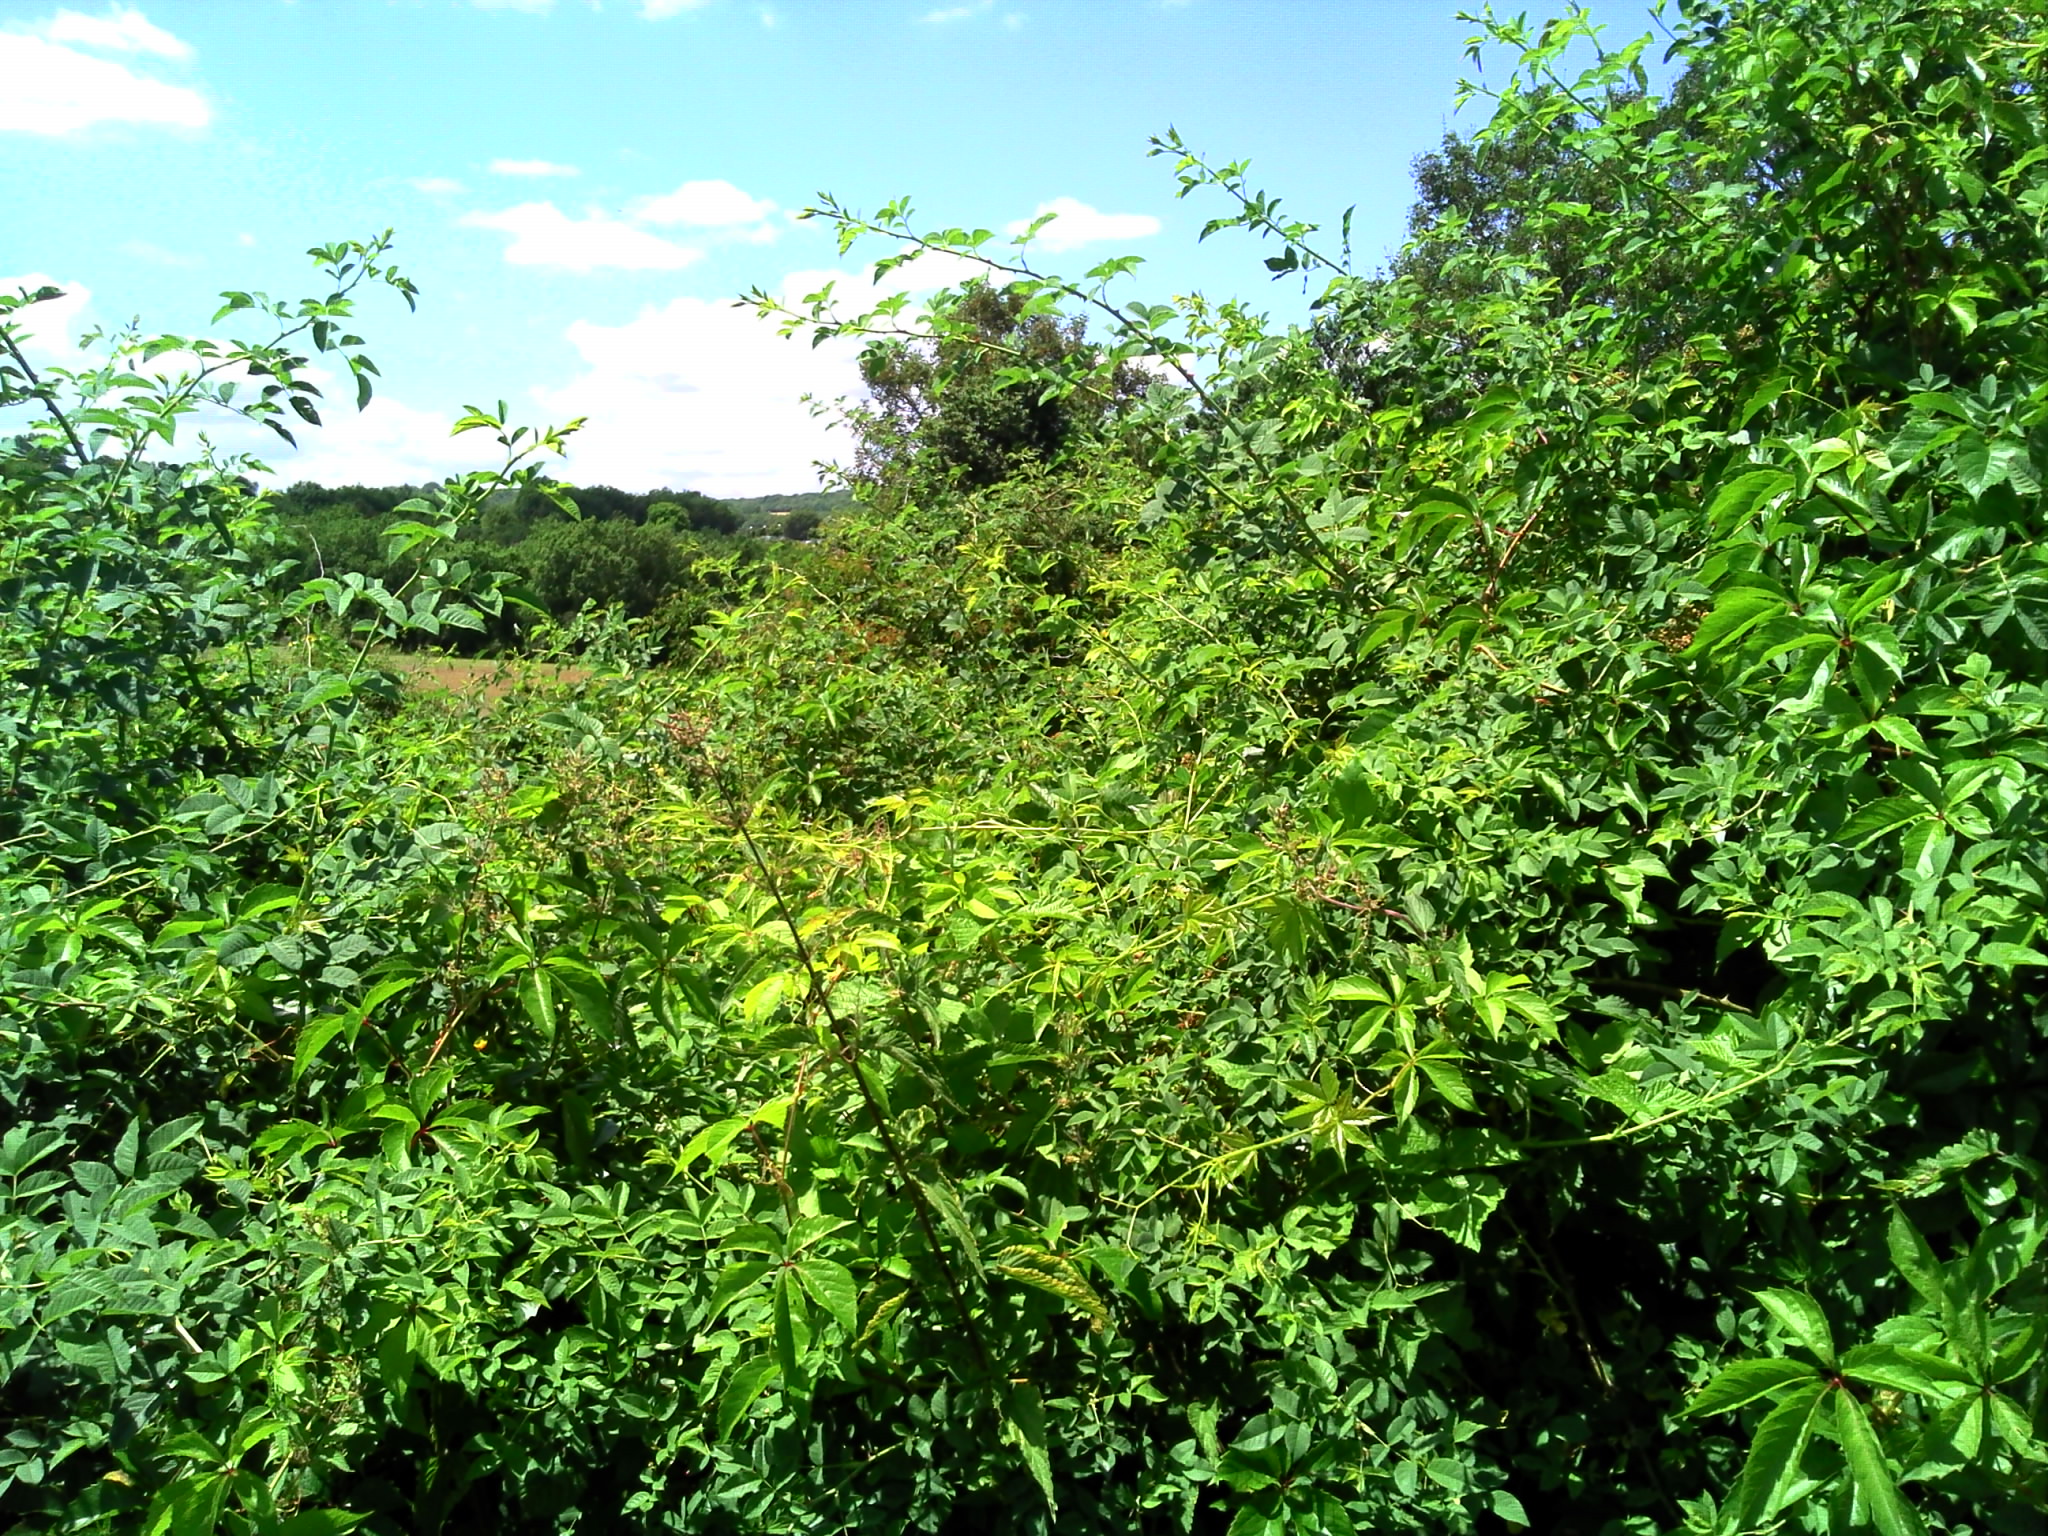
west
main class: Shrubland
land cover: Shrubland with sparse tree cover
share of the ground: > 75 %
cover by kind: shrubs 95 %, broadleaved forest trees 5 %
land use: Abandoned areas
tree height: < 5 m
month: June
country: FR
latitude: 44.9334
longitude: 1.5957
